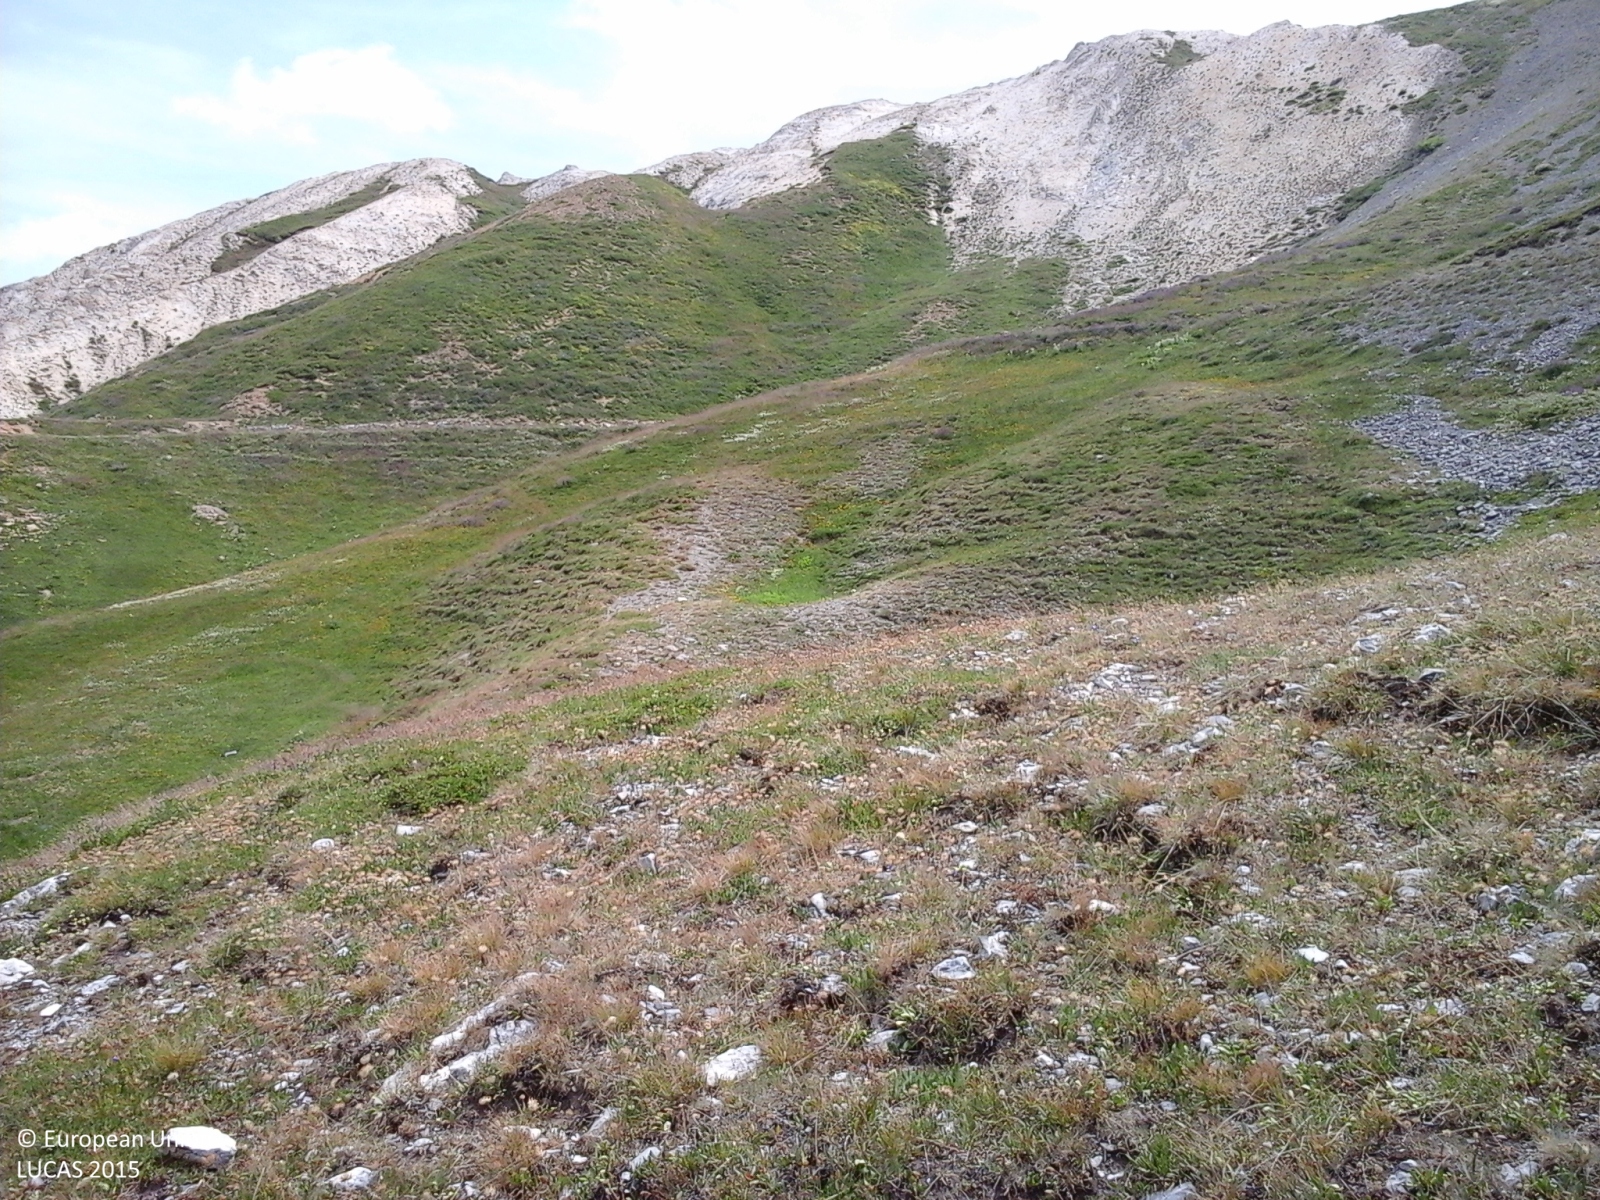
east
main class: Grassland
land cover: Grassland without tree/shrub cover
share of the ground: > 75 %
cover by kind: herbaceous plants 80 %, consolidated bare surface 20 %
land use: Agriculture (excluding fallow land and kitchen gardens)
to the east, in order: Grassland without tree/shrub cover; Tracks; Grassland without tree/shrub cover; Rocks and stones
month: July
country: IT
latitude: 44.3810
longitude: 7.0563
